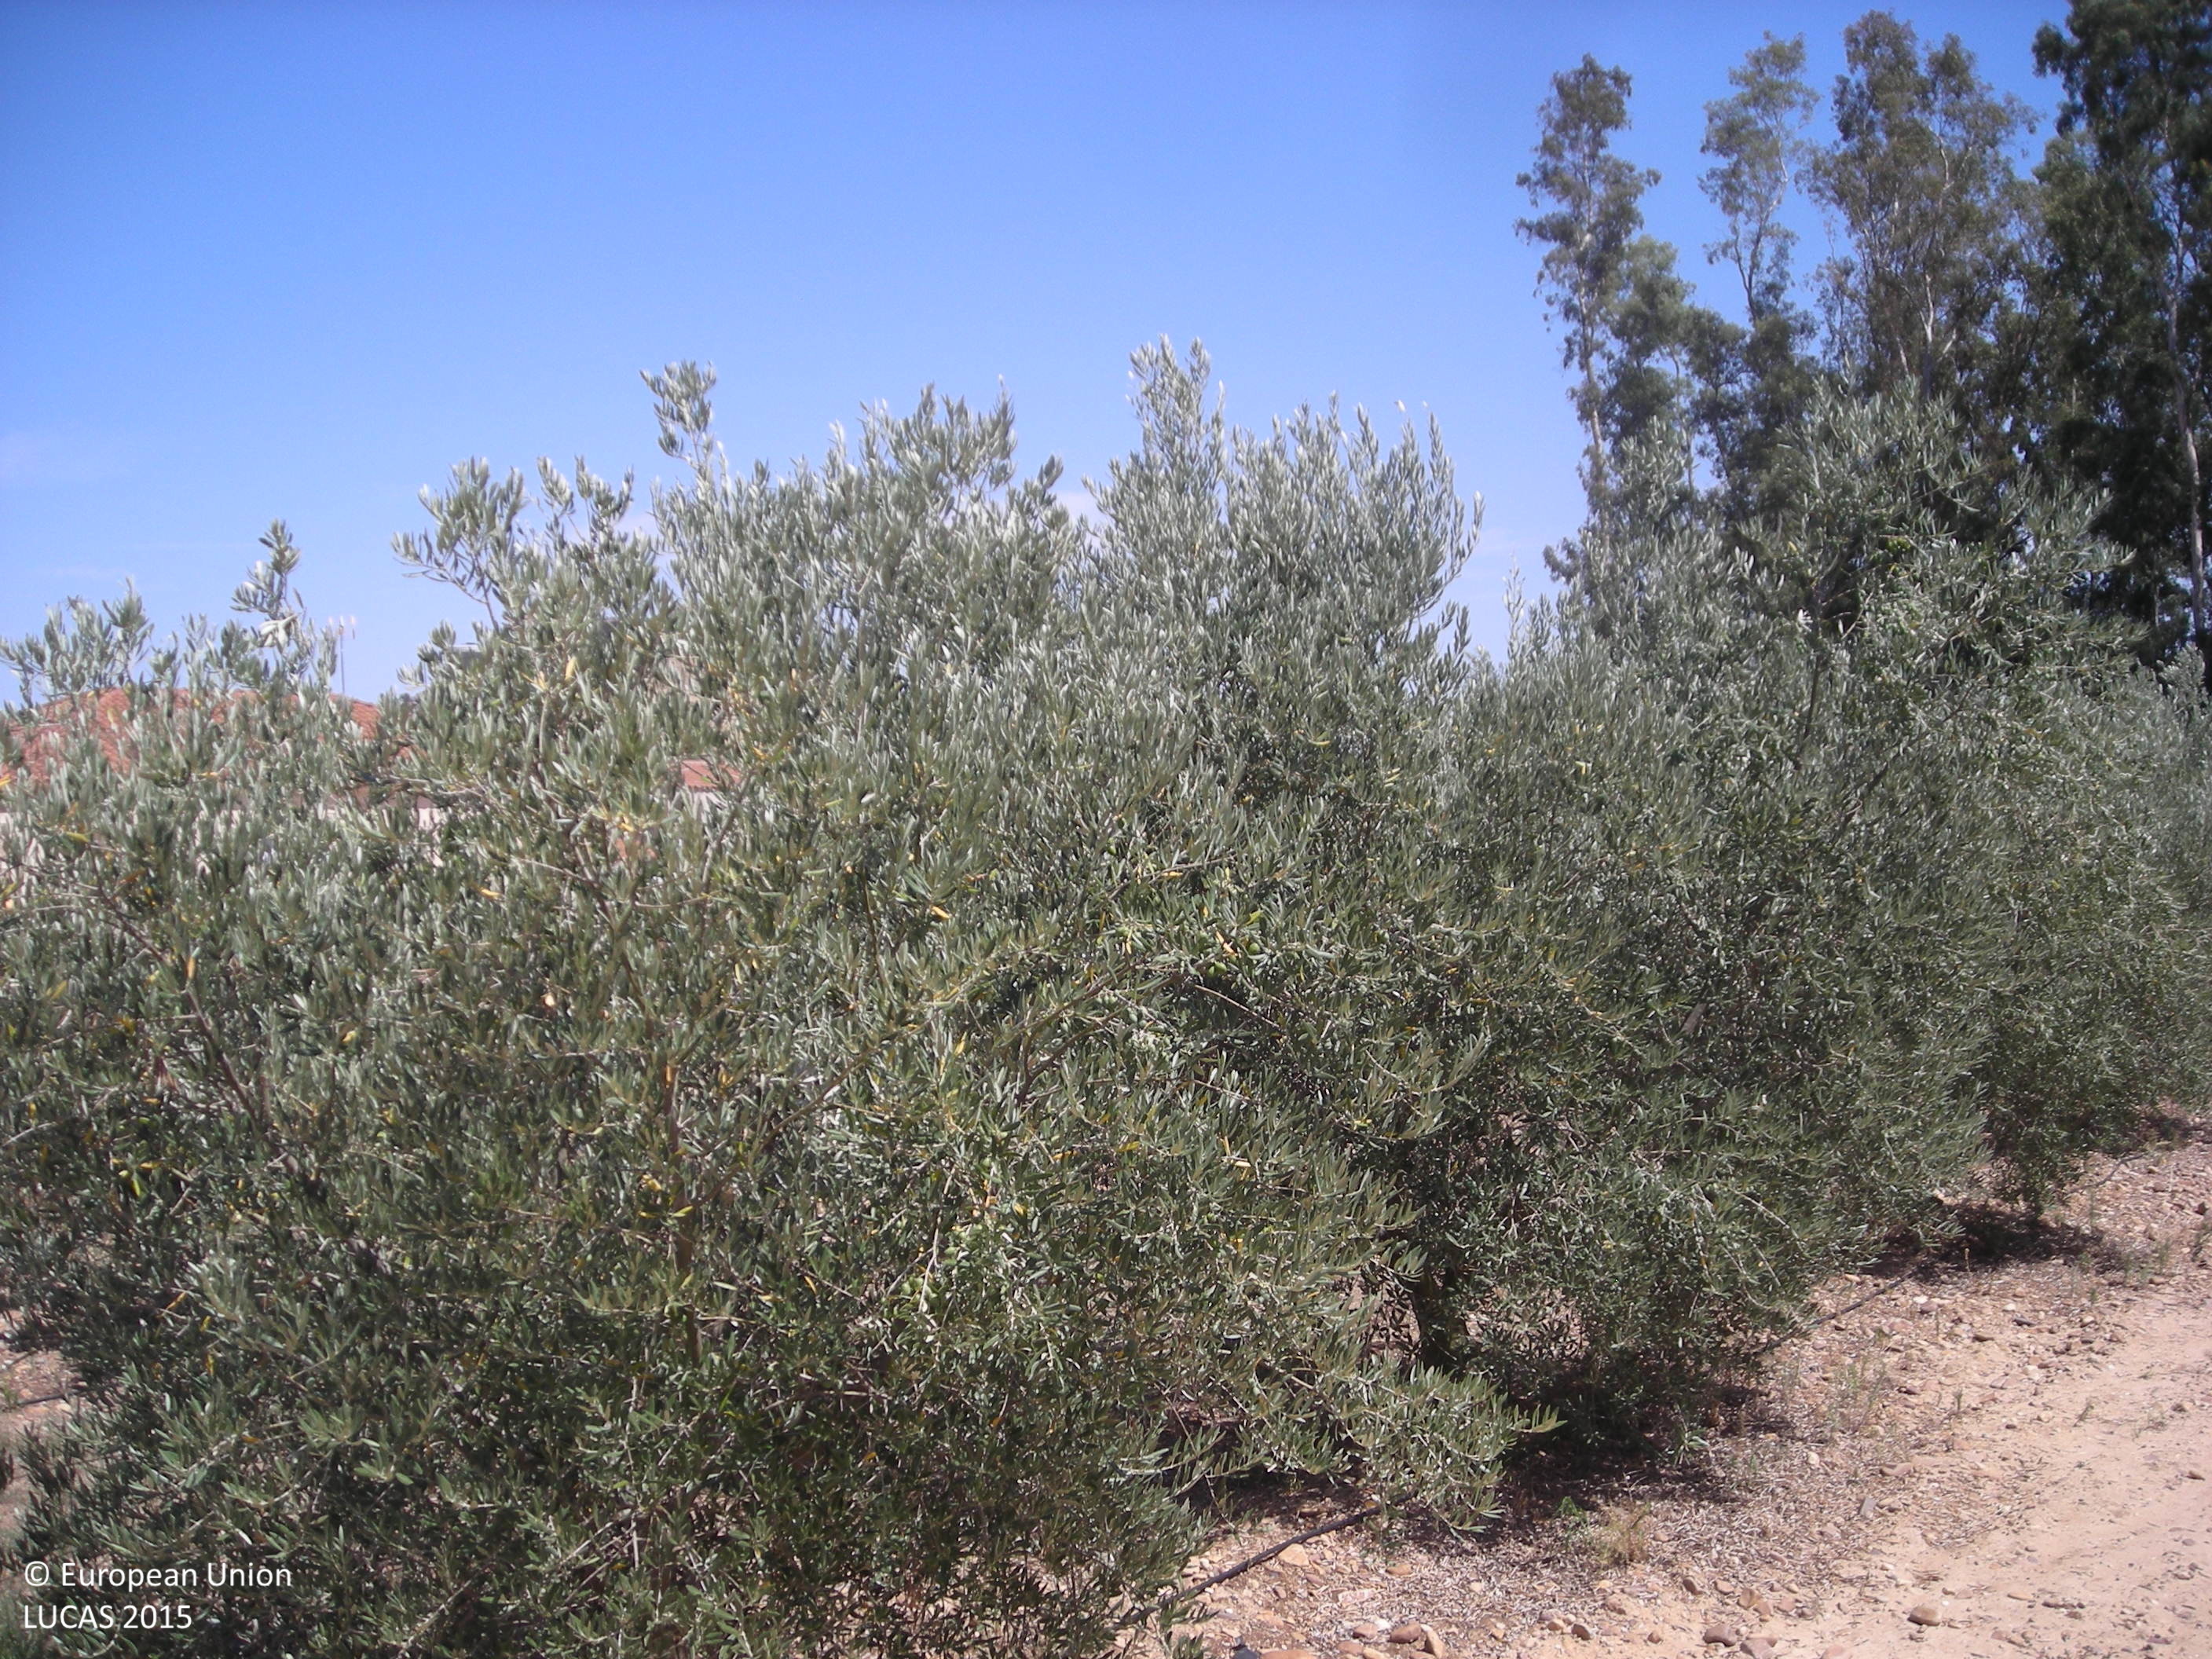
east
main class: Cropland
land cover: Olive groves
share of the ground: 25 - 50 %
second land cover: Other bare soil
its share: > 75 %
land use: Agriculture (excluding fallow land and kitchen gardens)
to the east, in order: Olive groves; Other bare soil; Fences; Broadleaved woodland; Olive groves; Tracks; Grassland with sparse tree/shrub cover; Tracks; Grassland without tree/shrub cover; Shrubland without tree cover
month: July
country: ES
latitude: 38.9685
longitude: -5.9673
